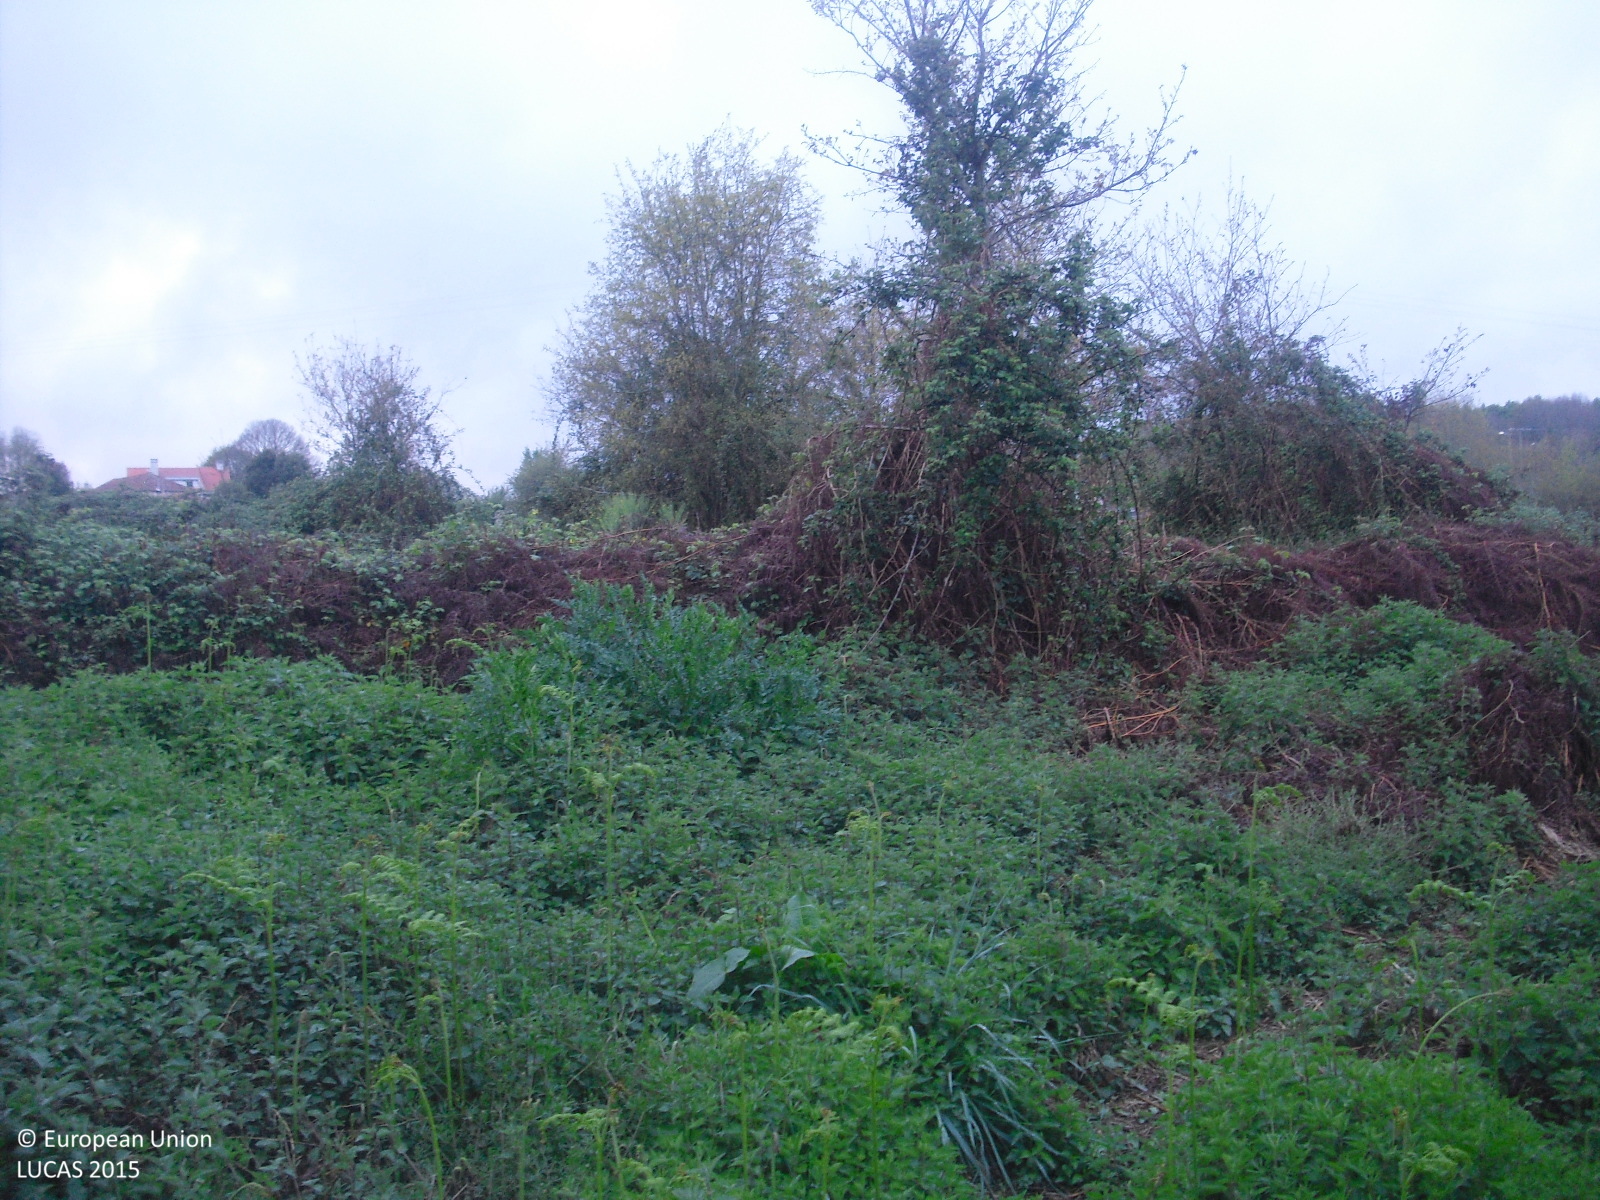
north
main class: Grassland
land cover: Grassland with sparse tree/shrub cover
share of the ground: > 75 %
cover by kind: herbaceous plants 85 %, shrubs 10 %, broadleaved forest trees 5 %
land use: Semi-natural and natural areas not in use
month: April
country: ES
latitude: 42.1071
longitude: -7.8379
